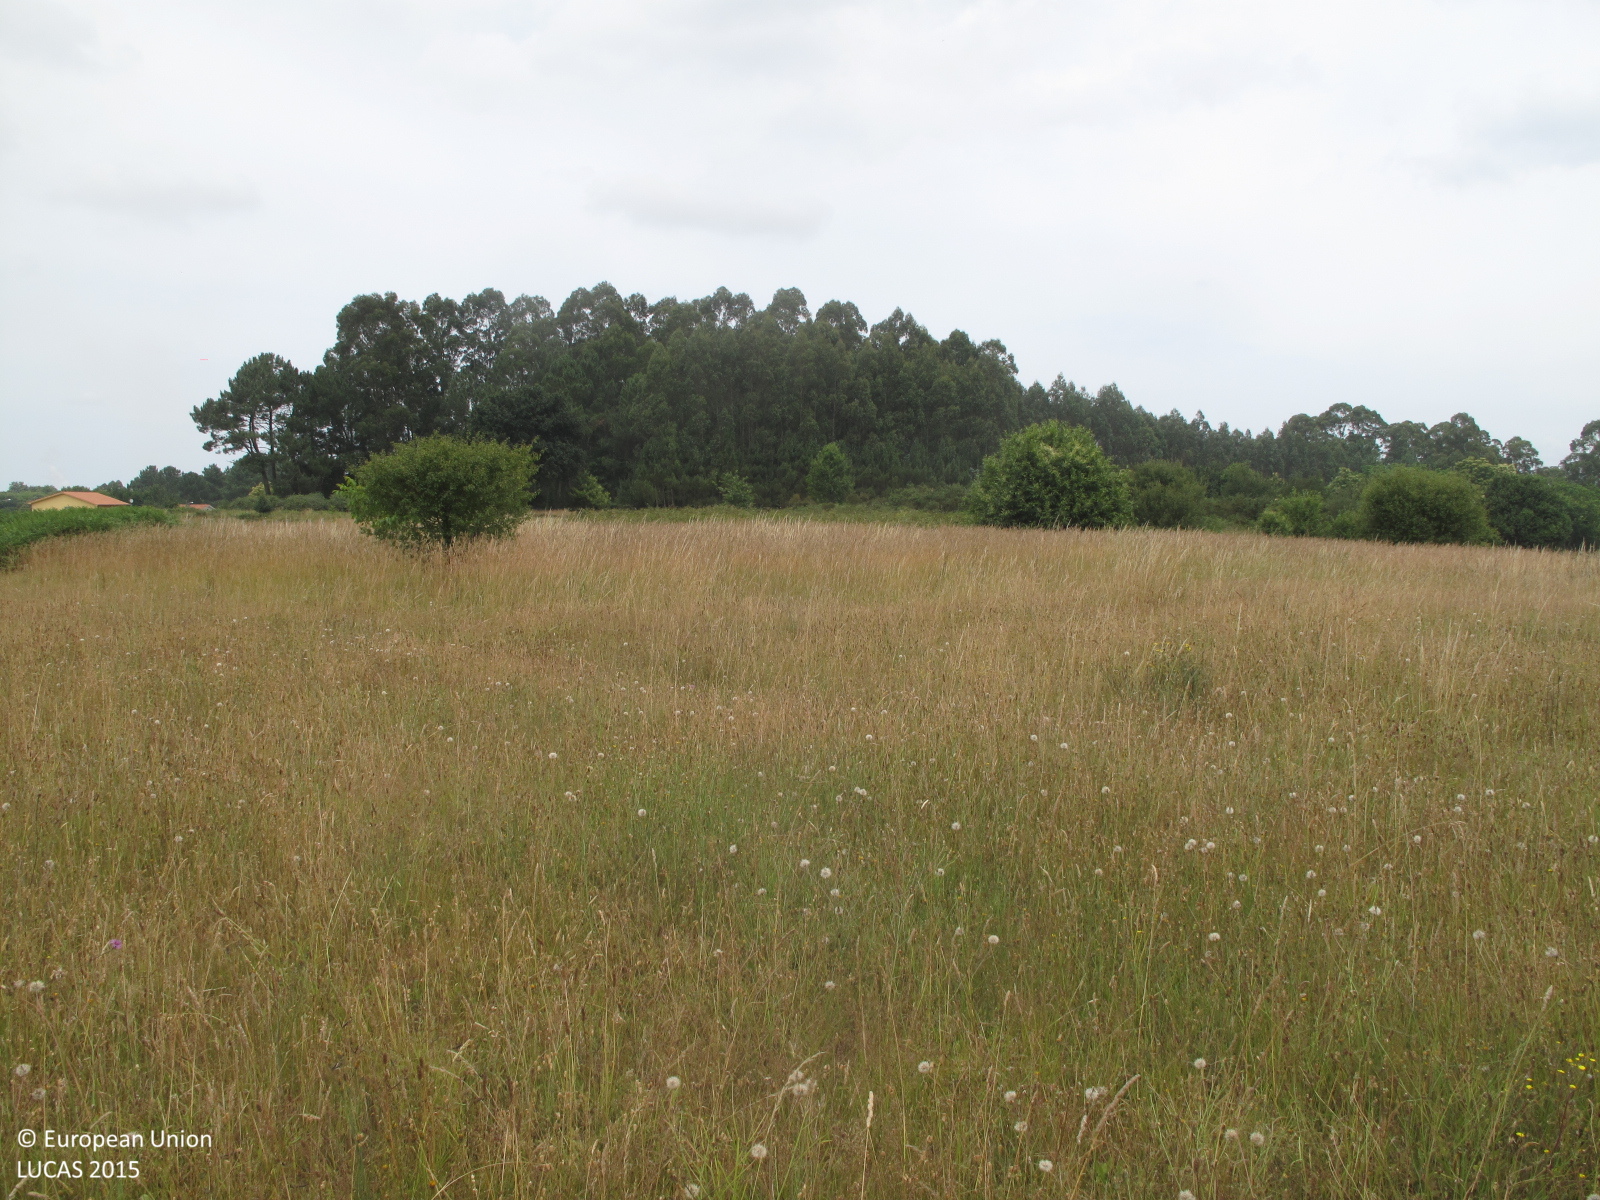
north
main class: Grassland
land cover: Spontaneously vegetated surfaces
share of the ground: > 75 %
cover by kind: herbaceous plants 100 %
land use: Abandoned areas
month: July
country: ES
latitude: 43.2559
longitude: -8.2194
